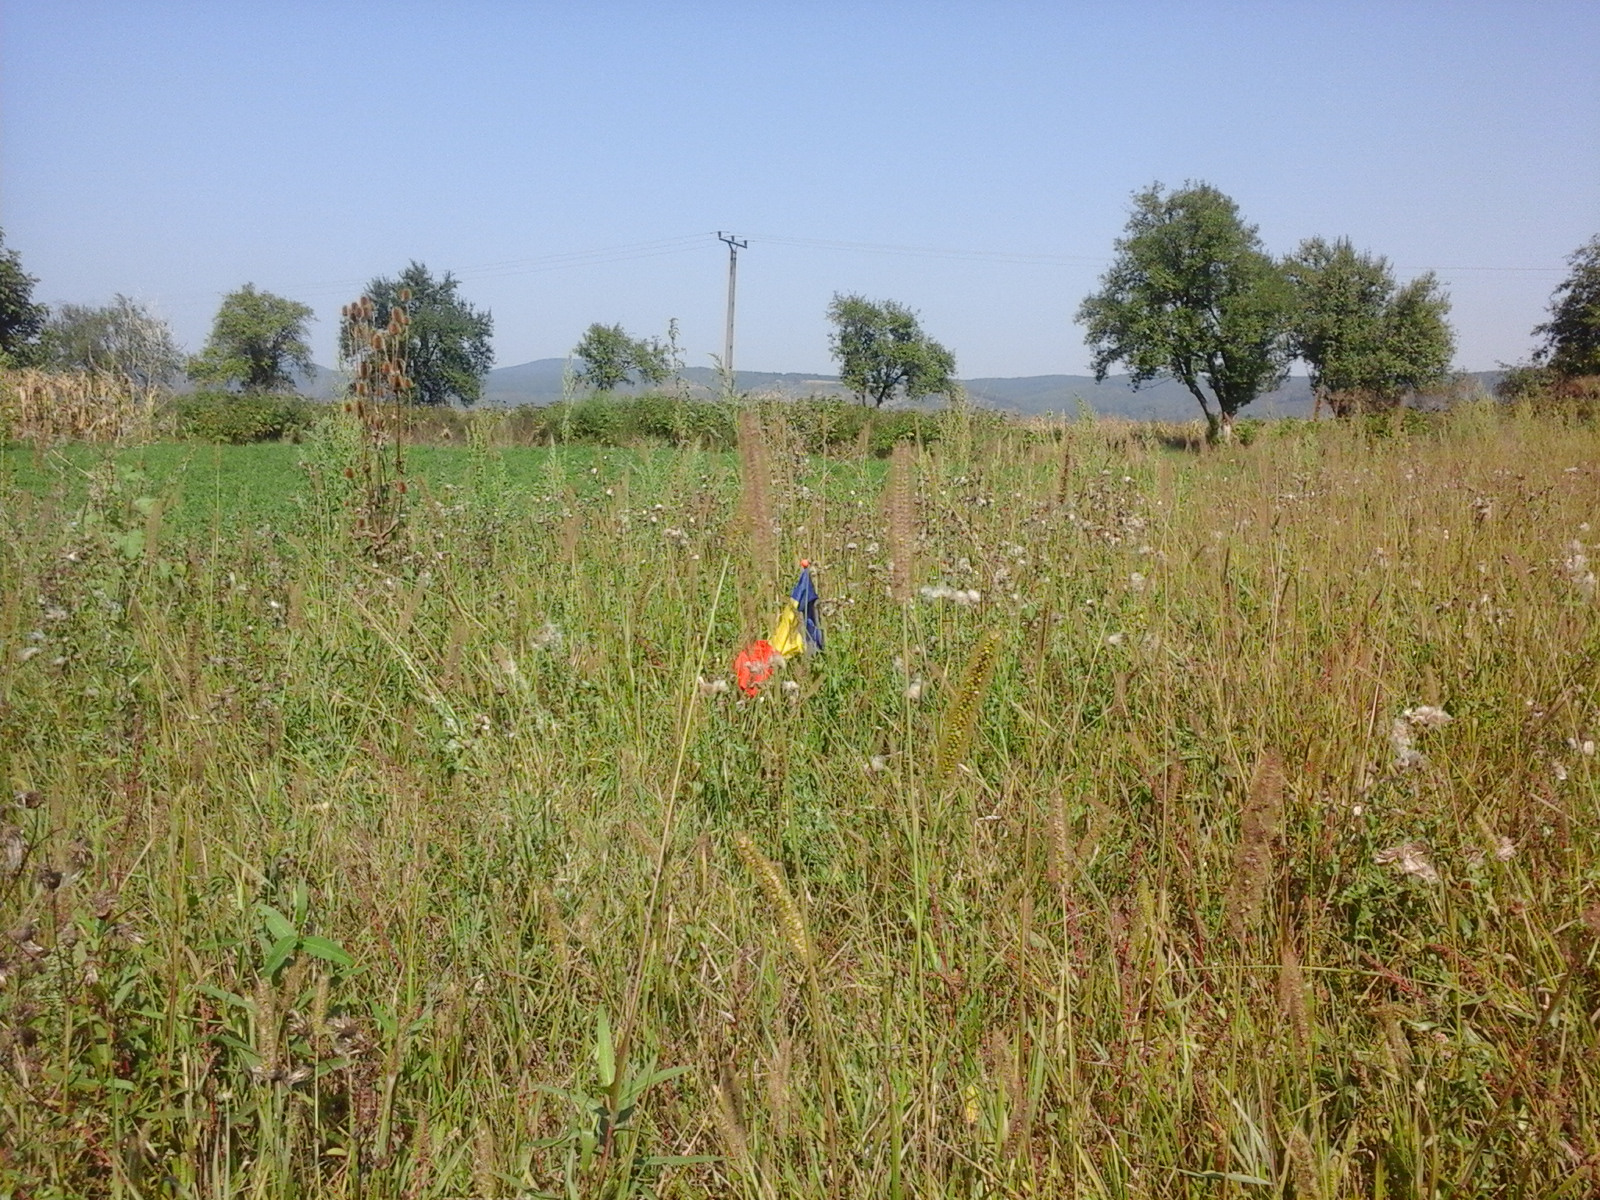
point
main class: Grassland
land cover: Spontaneously vegetated surfaces
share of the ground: > 75 %
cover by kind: herbaceous plants 100 %
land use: Agriculture (excluding fallow land and kitchen gardens)
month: August
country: RO
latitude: 45.9395
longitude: 22.6783
